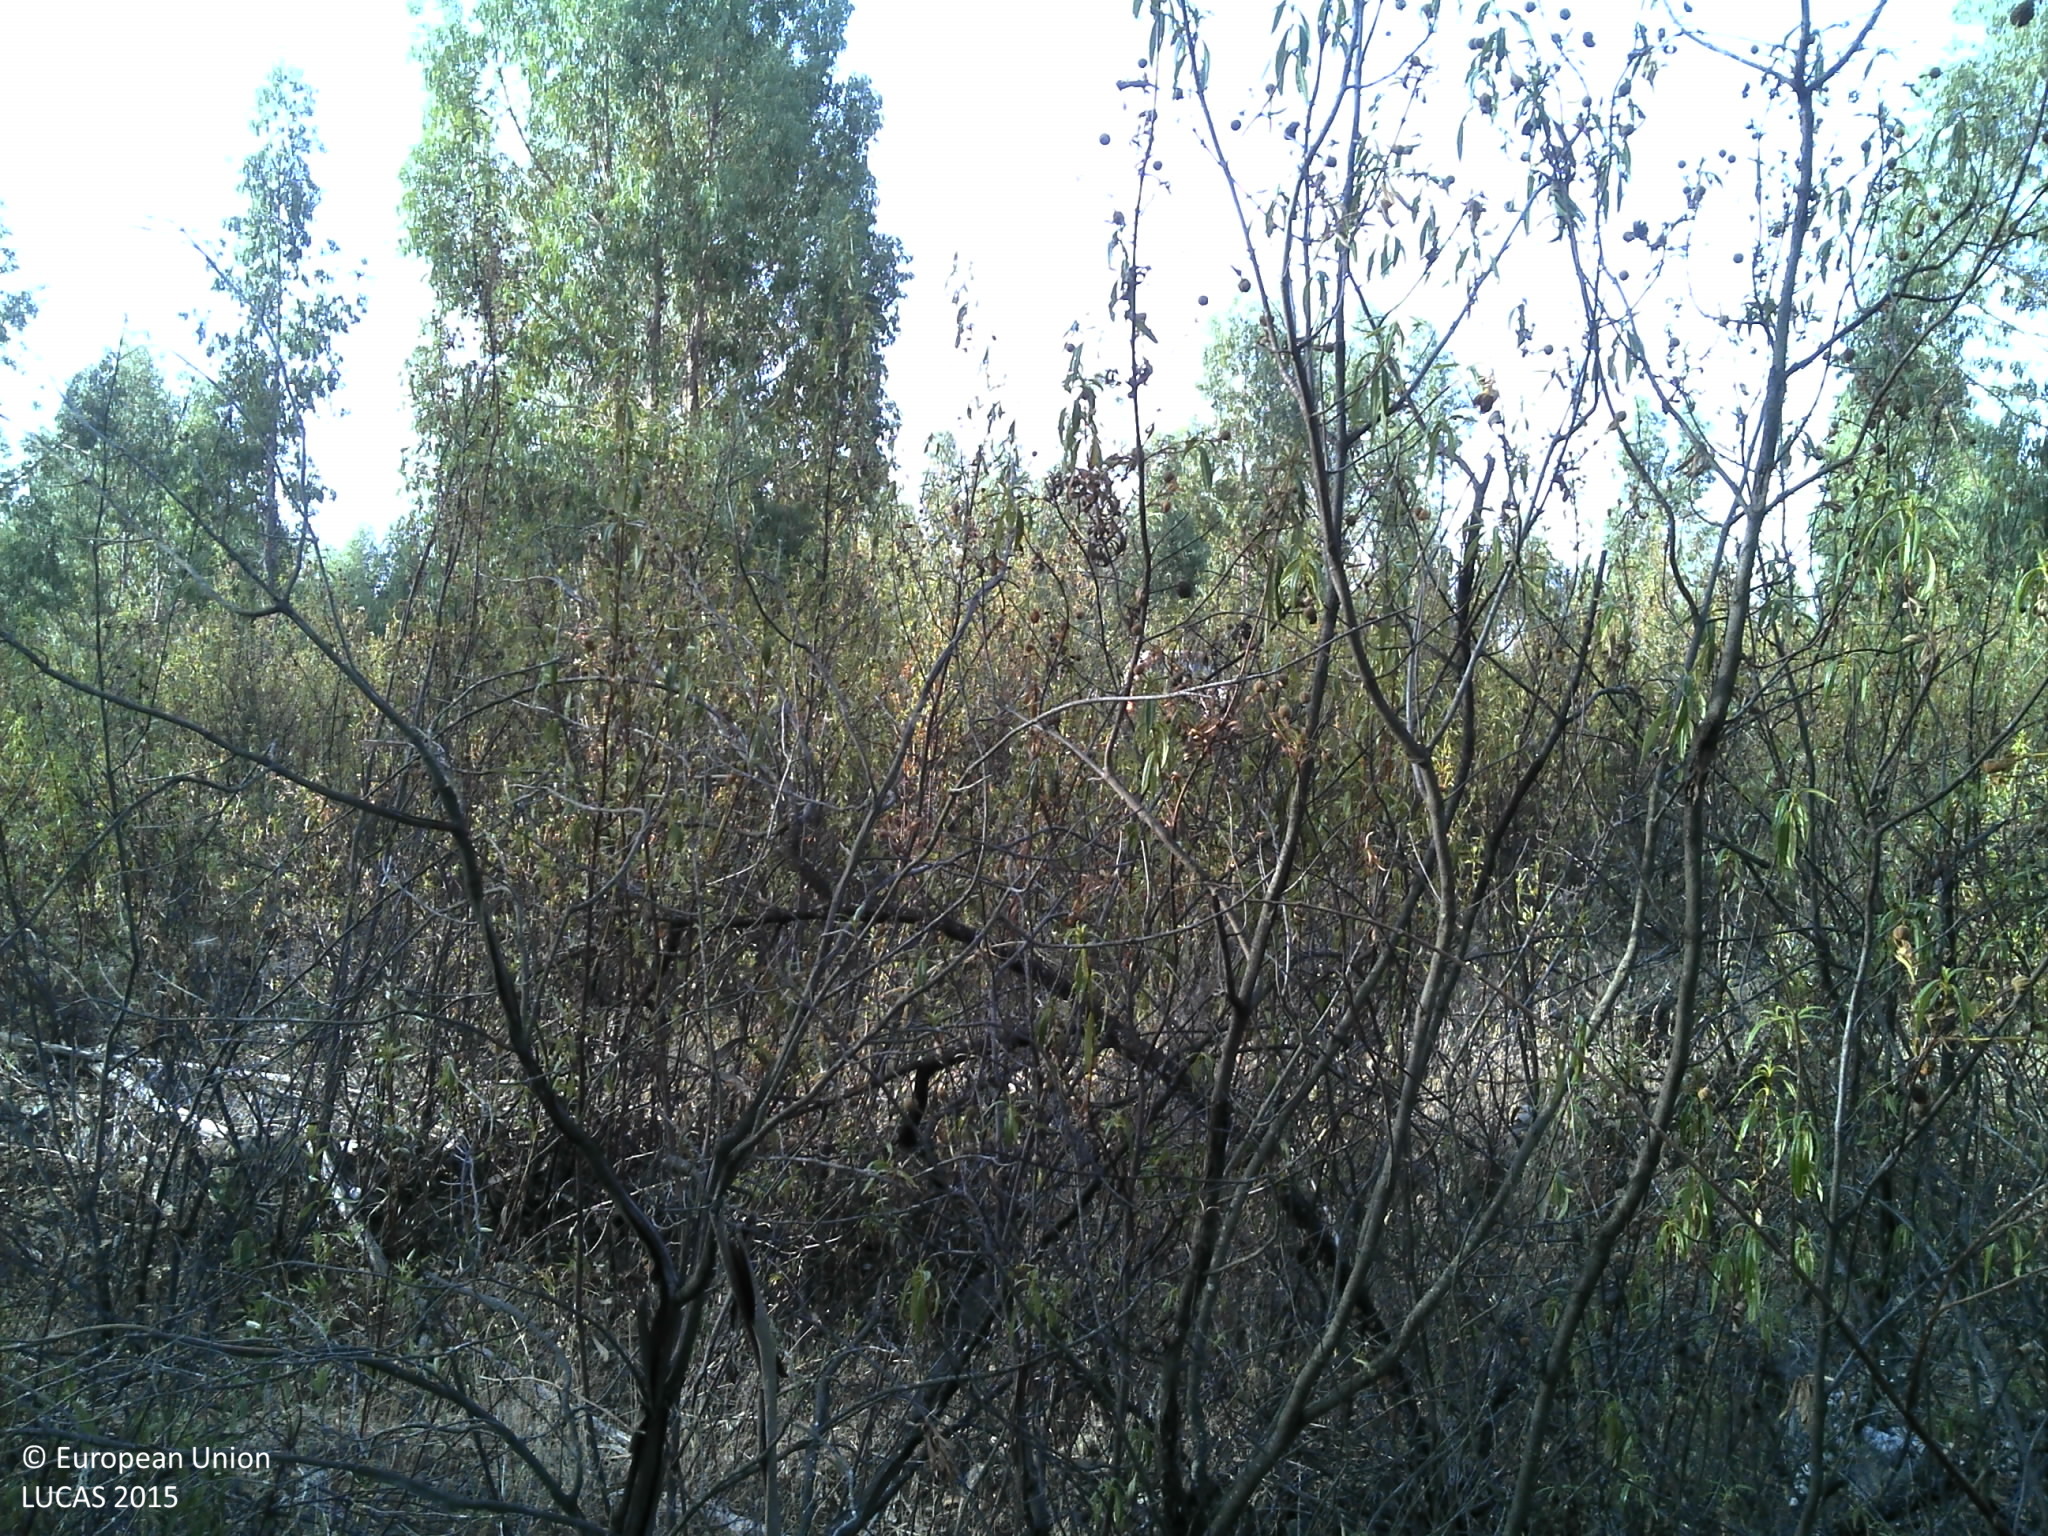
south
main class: Woodland
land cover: Broadleaved woodland
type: exotic forest
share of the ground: 25 - 50 %
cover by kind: shrubs 50 %, broadleaved forest trees 40 %, unconsolidated bare surface 10 %
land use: Forestry
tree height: > 5 m
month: July
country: PT
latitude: 38.6549
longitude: -7.4390
